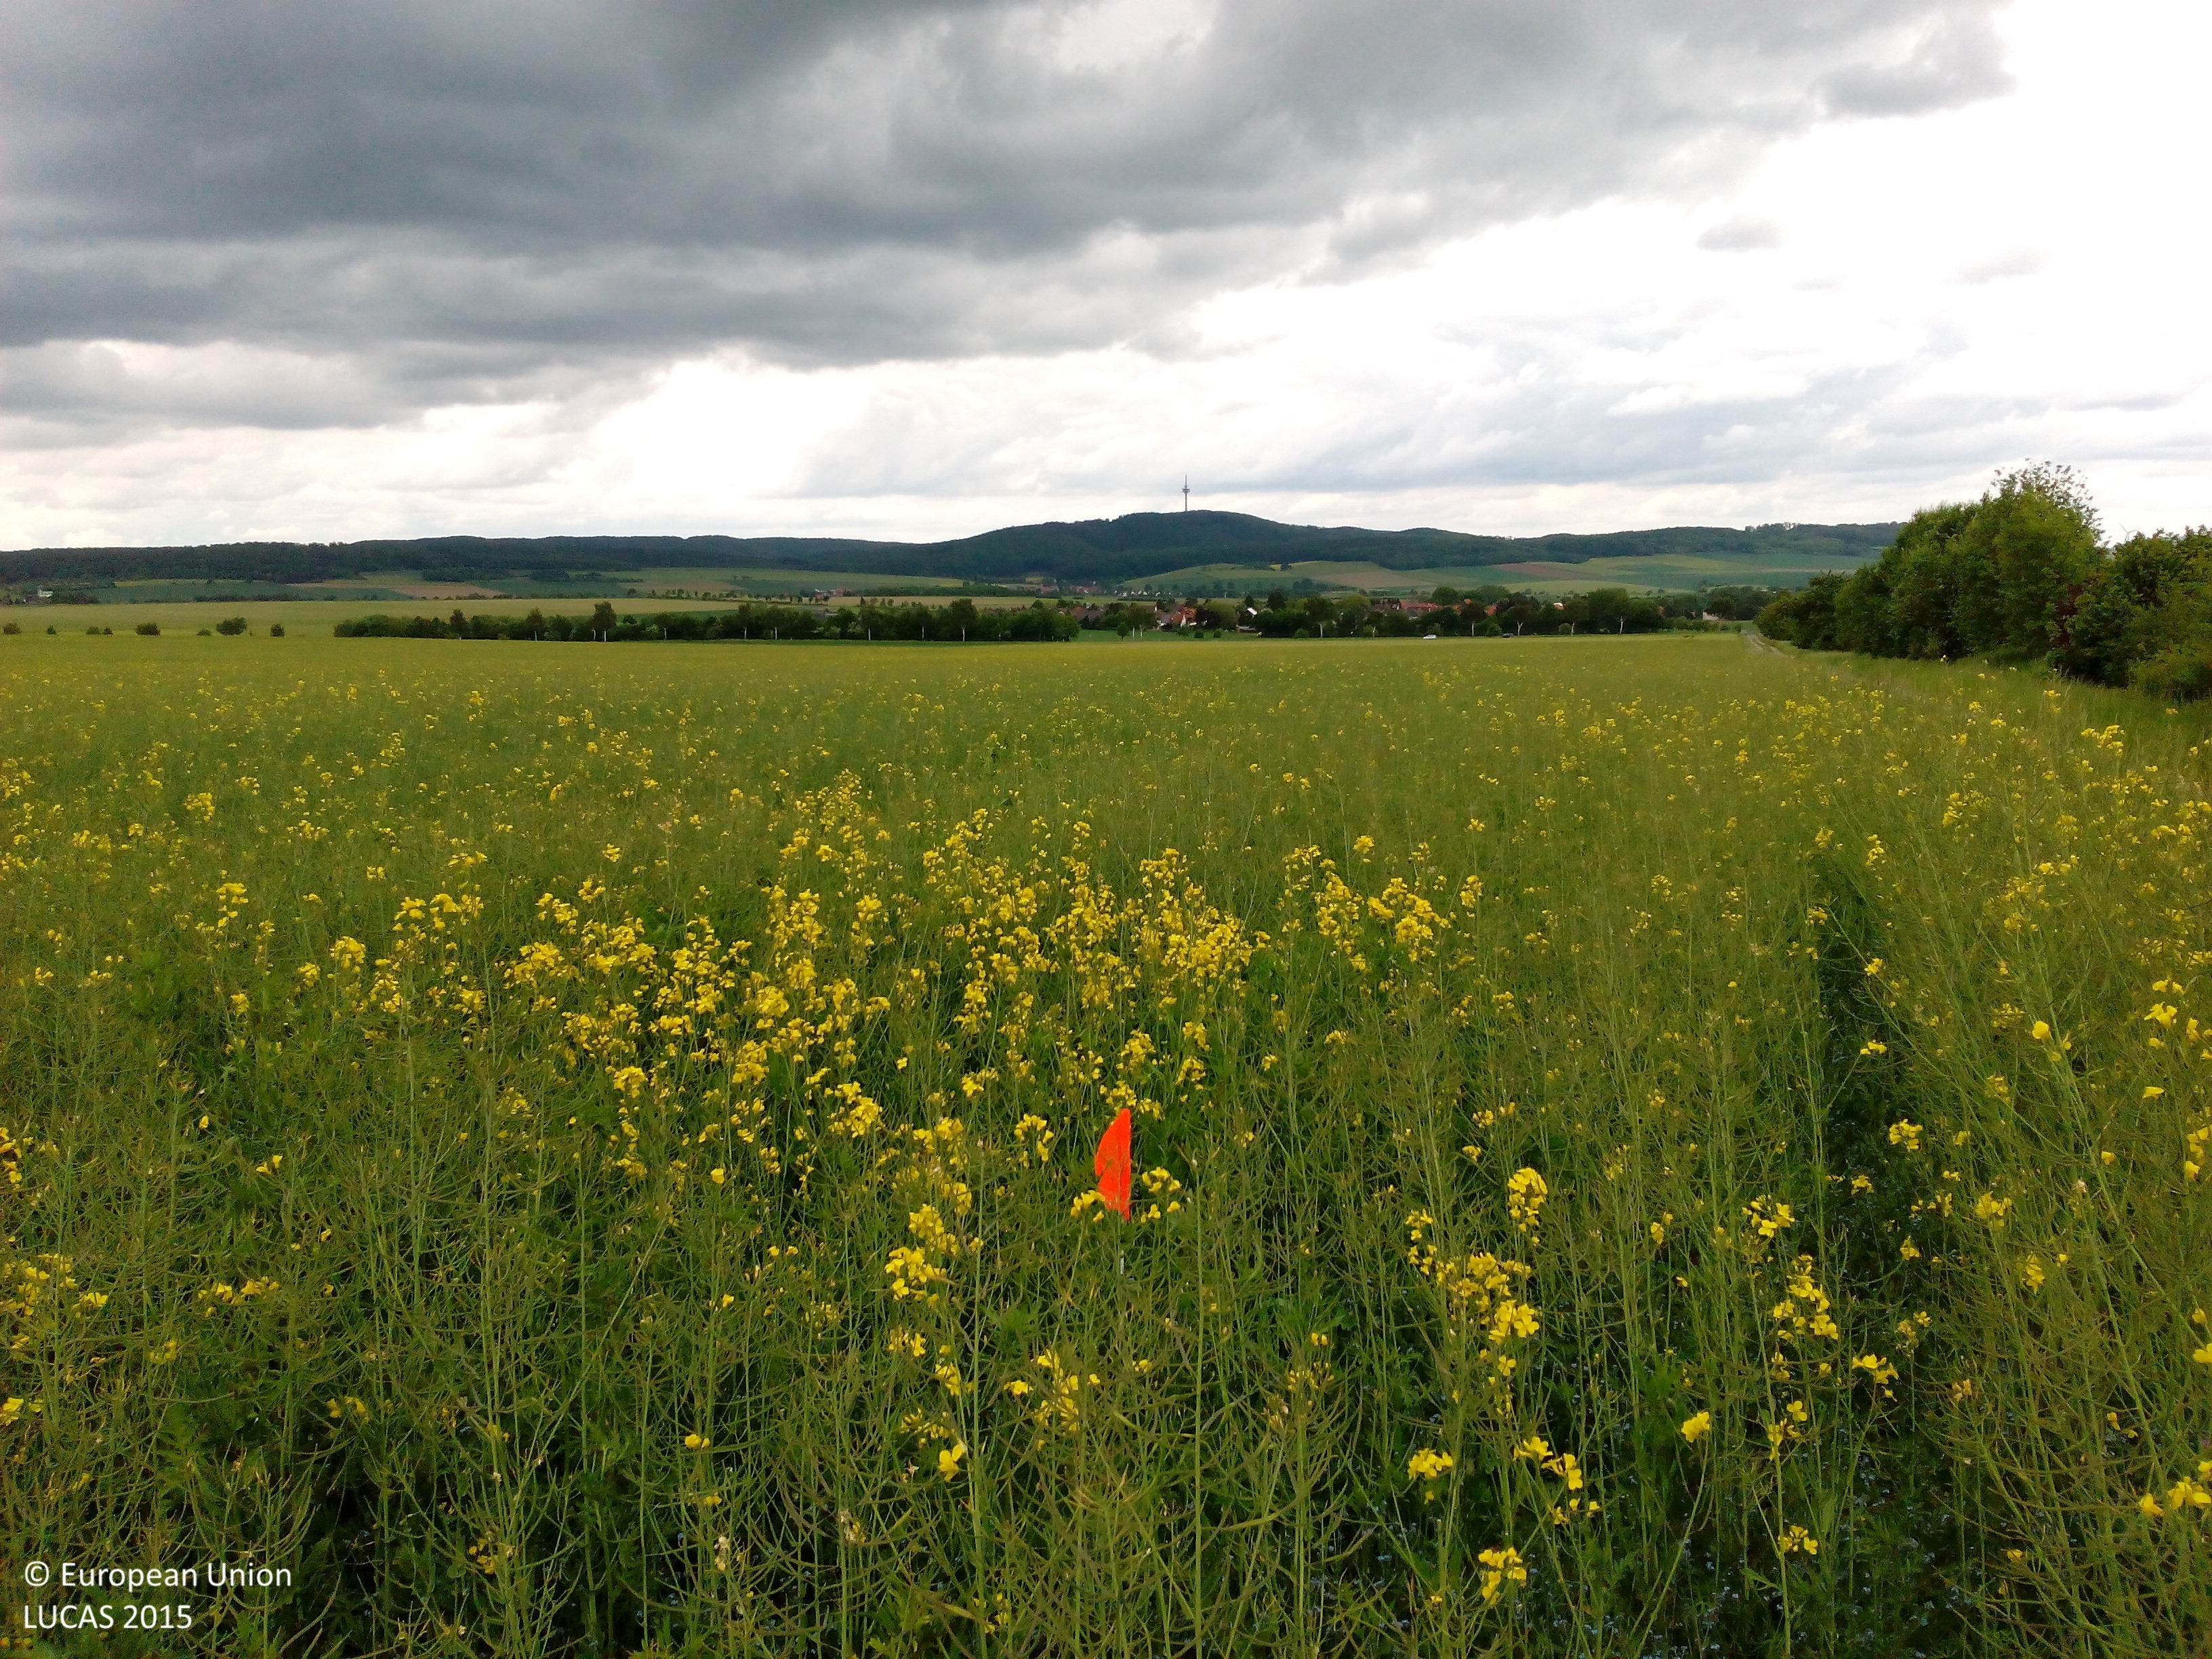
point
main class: Cropland
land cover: Rape and turnip rape
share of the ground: > 75 %
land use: Agriculture (excluding fallow land and kitchen gardens)
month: May
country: DE
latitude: 52.0359
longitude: 9.8980
